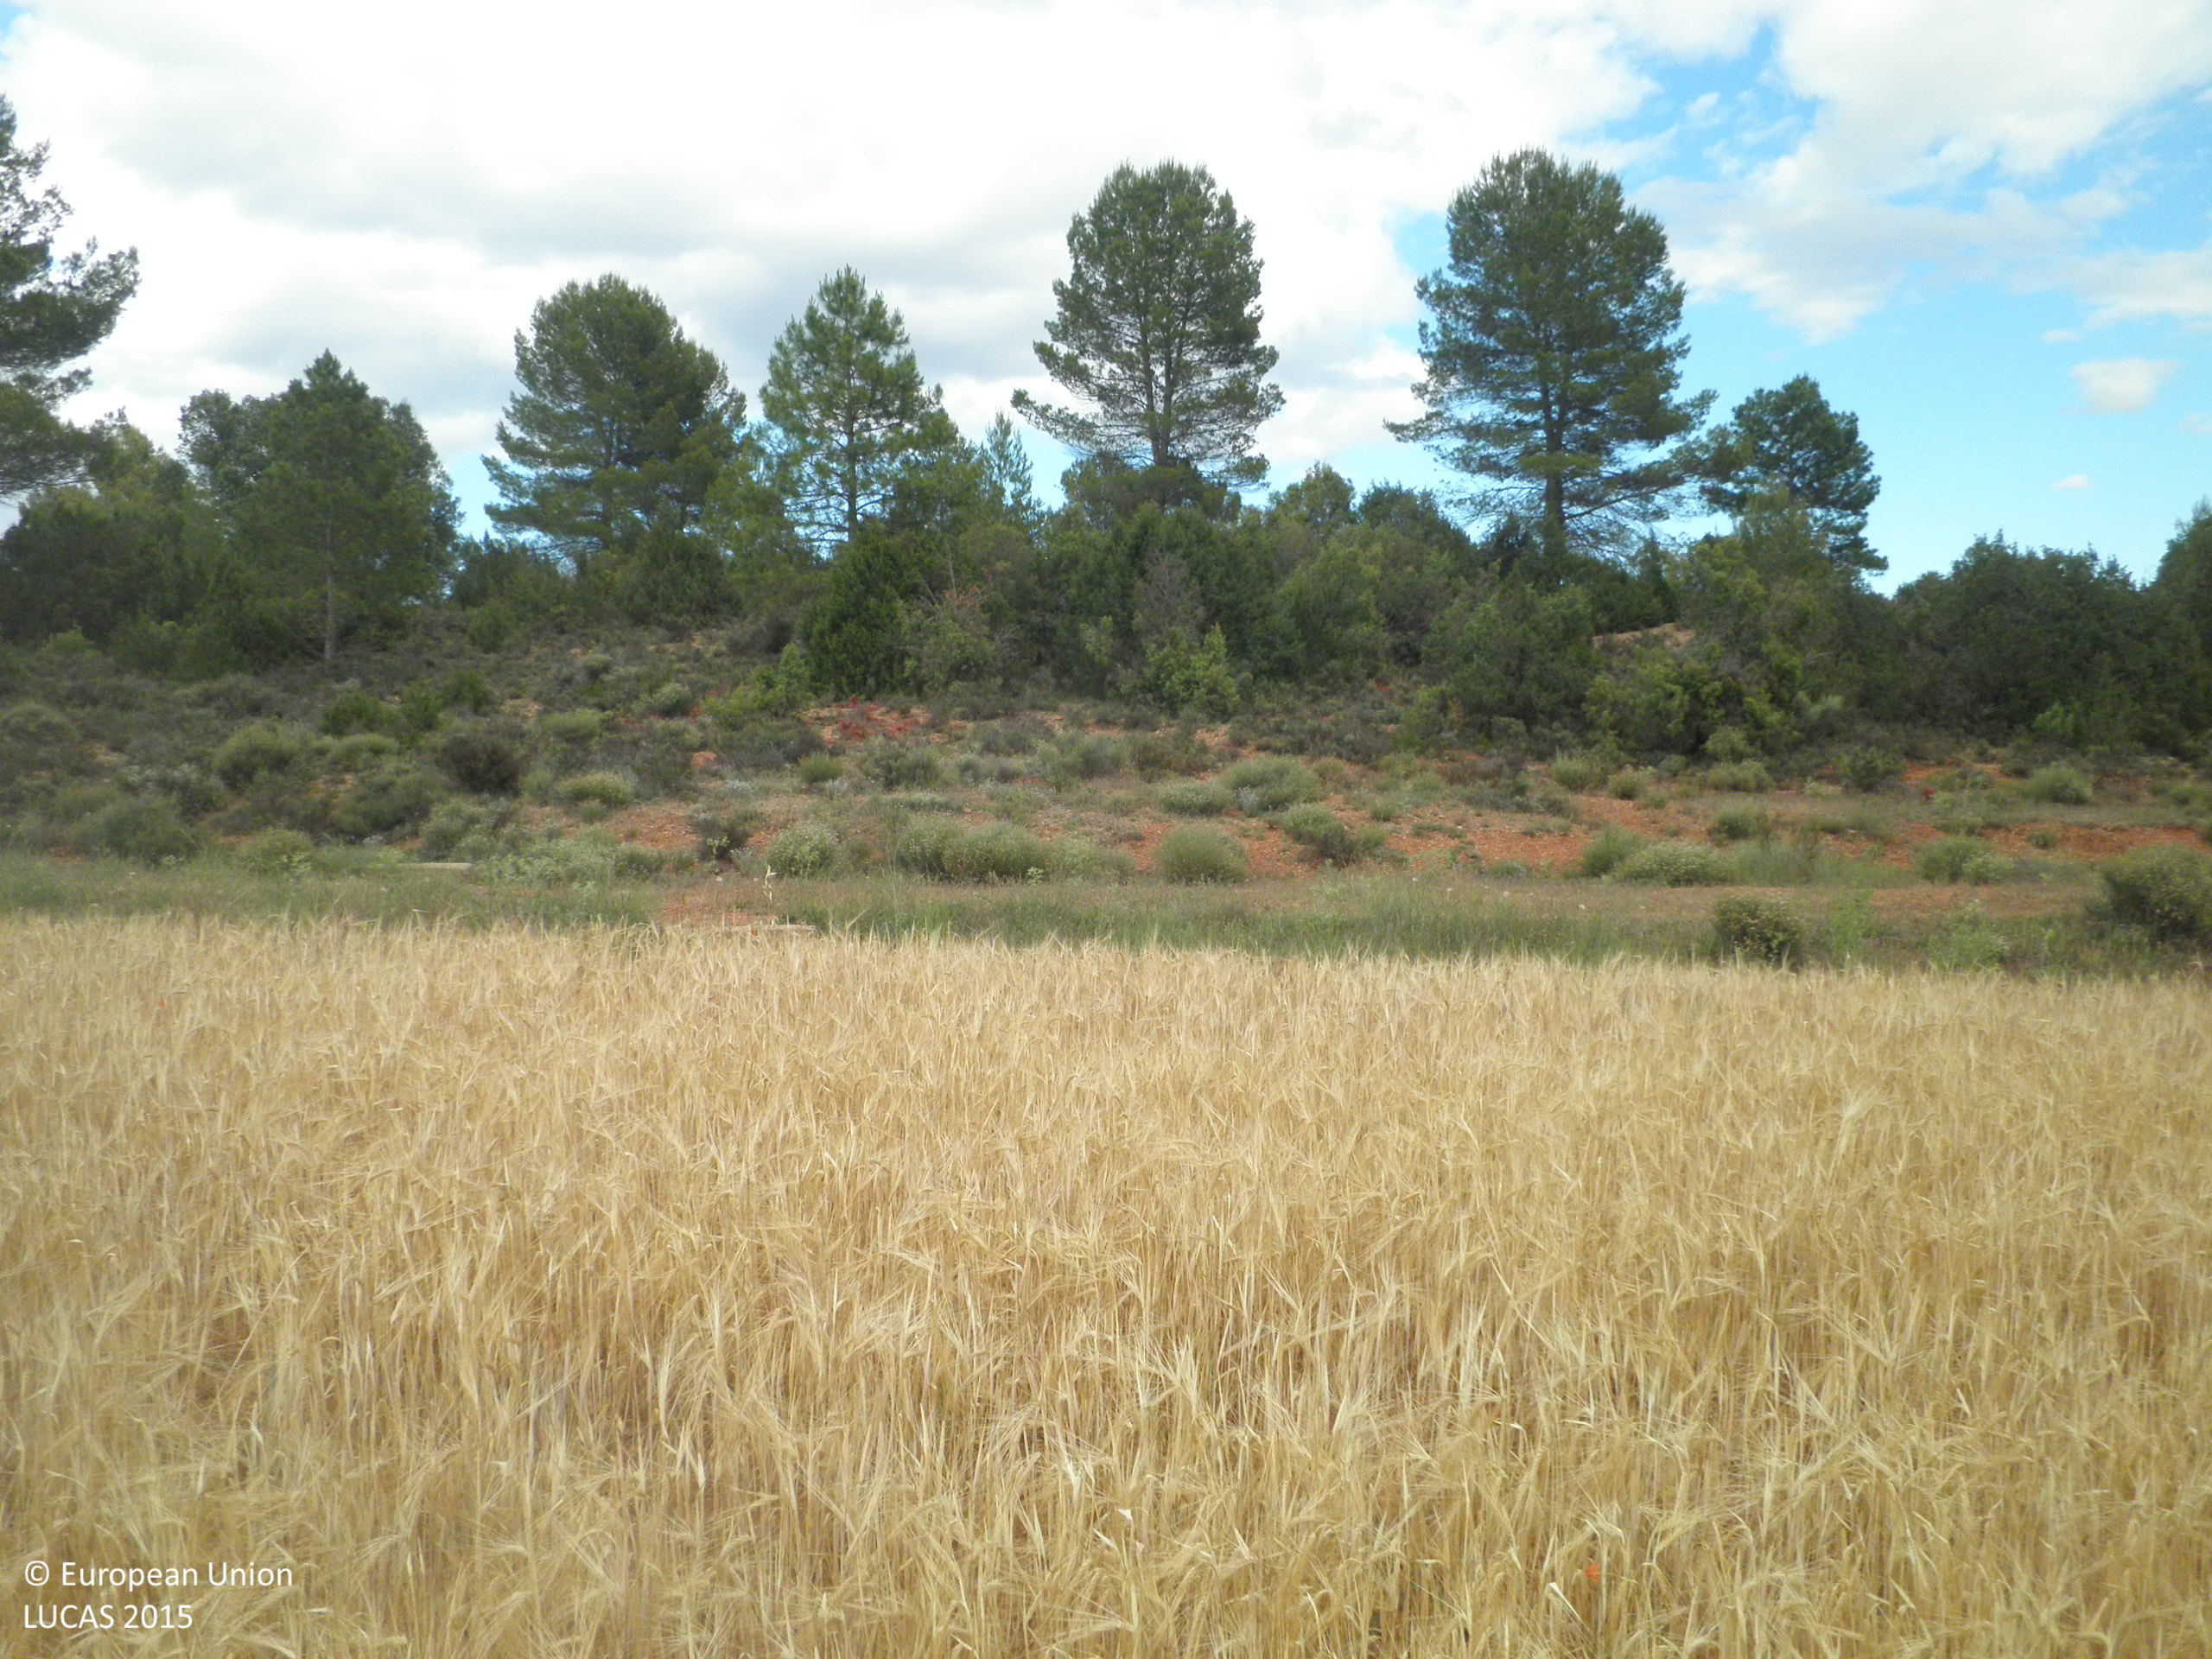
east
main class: Cropland
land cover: Barley
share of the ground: > 75 %
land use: Agriculture (excluding fallow land and kitchen gardens)
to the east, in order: Barley; Grass margins; Tracks; Grass margins; Pine dominated coniferous woodland; Tracks; Pine dominated coniferous woodland; Other mixed woodland; Shrubland without tree cover; Shrubland with sparse tree cover
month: June
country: ES
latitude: 39.7485
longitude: -1.6906
